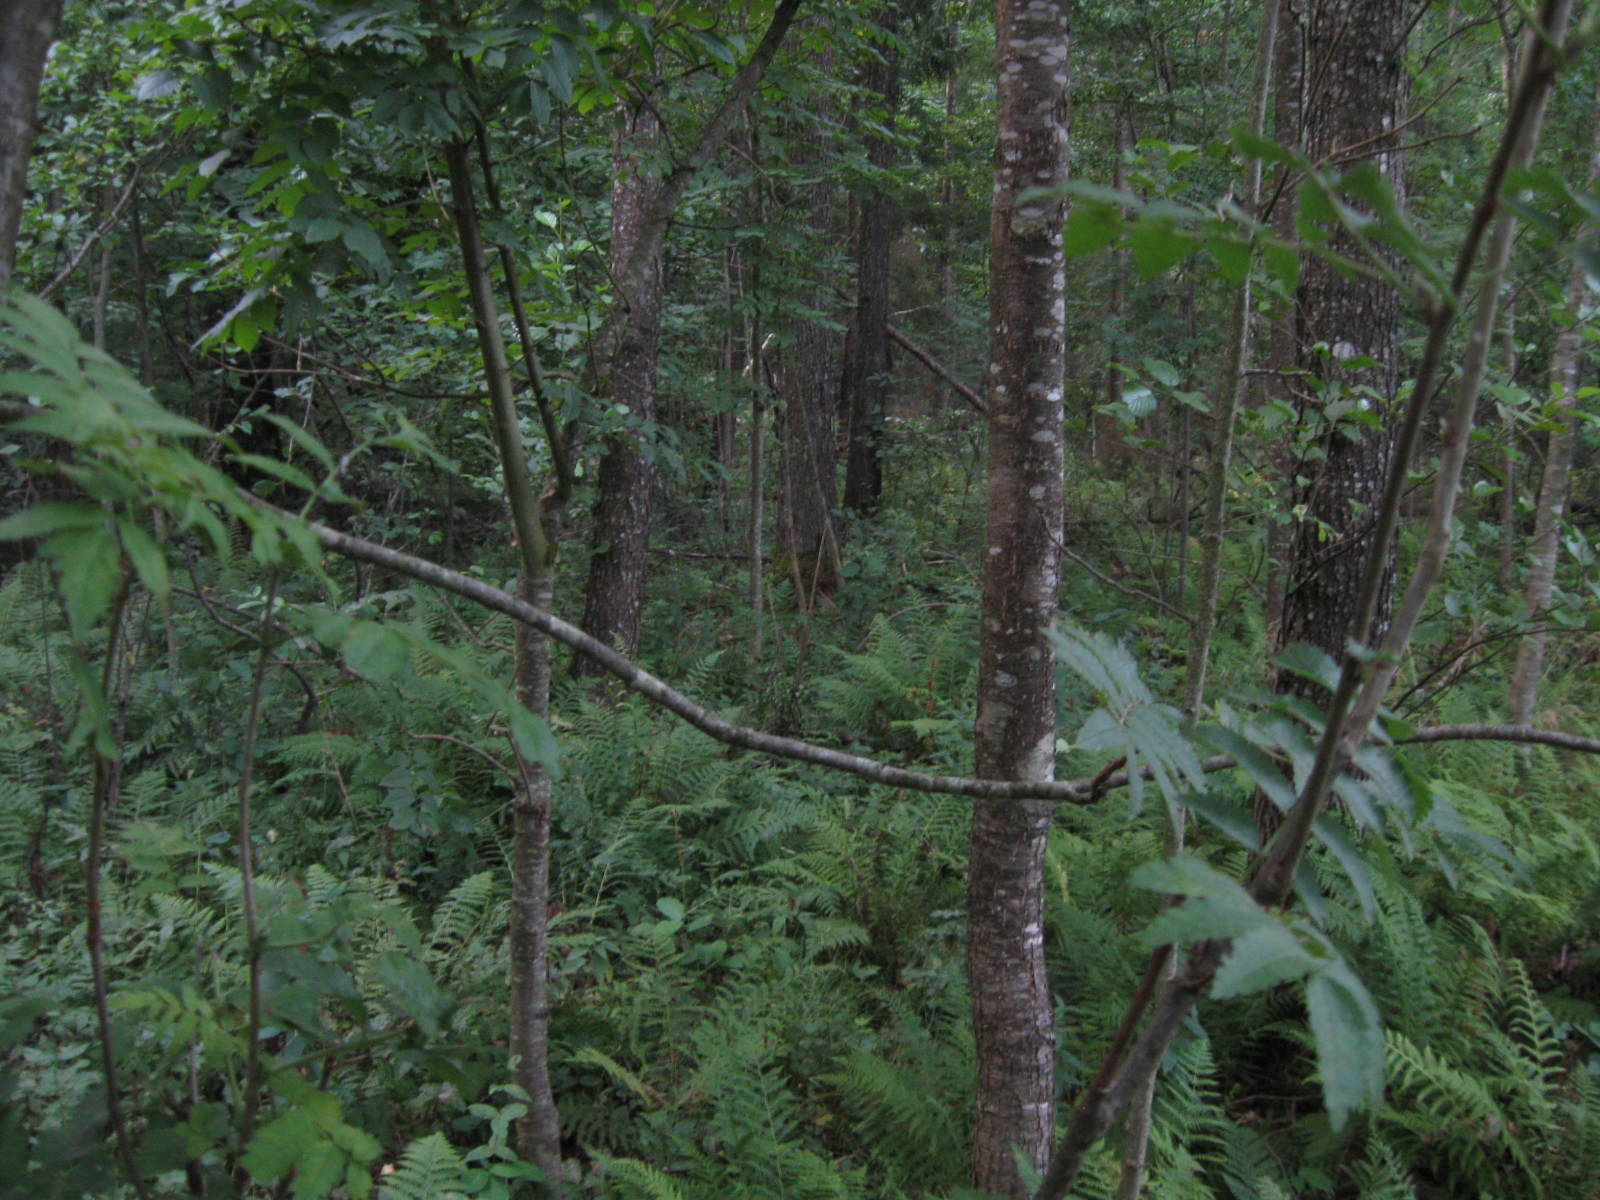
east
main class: Woodland
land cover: Broadleaved woodland
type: non-riverine alder, birch or aspen forest
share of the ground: > 75 %
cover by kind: broadleaved forest trees 80 %, herbaceous plants 15 %, coniferous forest trees 5 %
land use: Forestry
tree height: > 5 m
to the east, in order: Broadleaved woodland; Spruce dominated mixed woodland; Ditches and canals; Broadleaved woodland
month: July
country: LT
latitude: 54.7392
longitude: 23.8341
